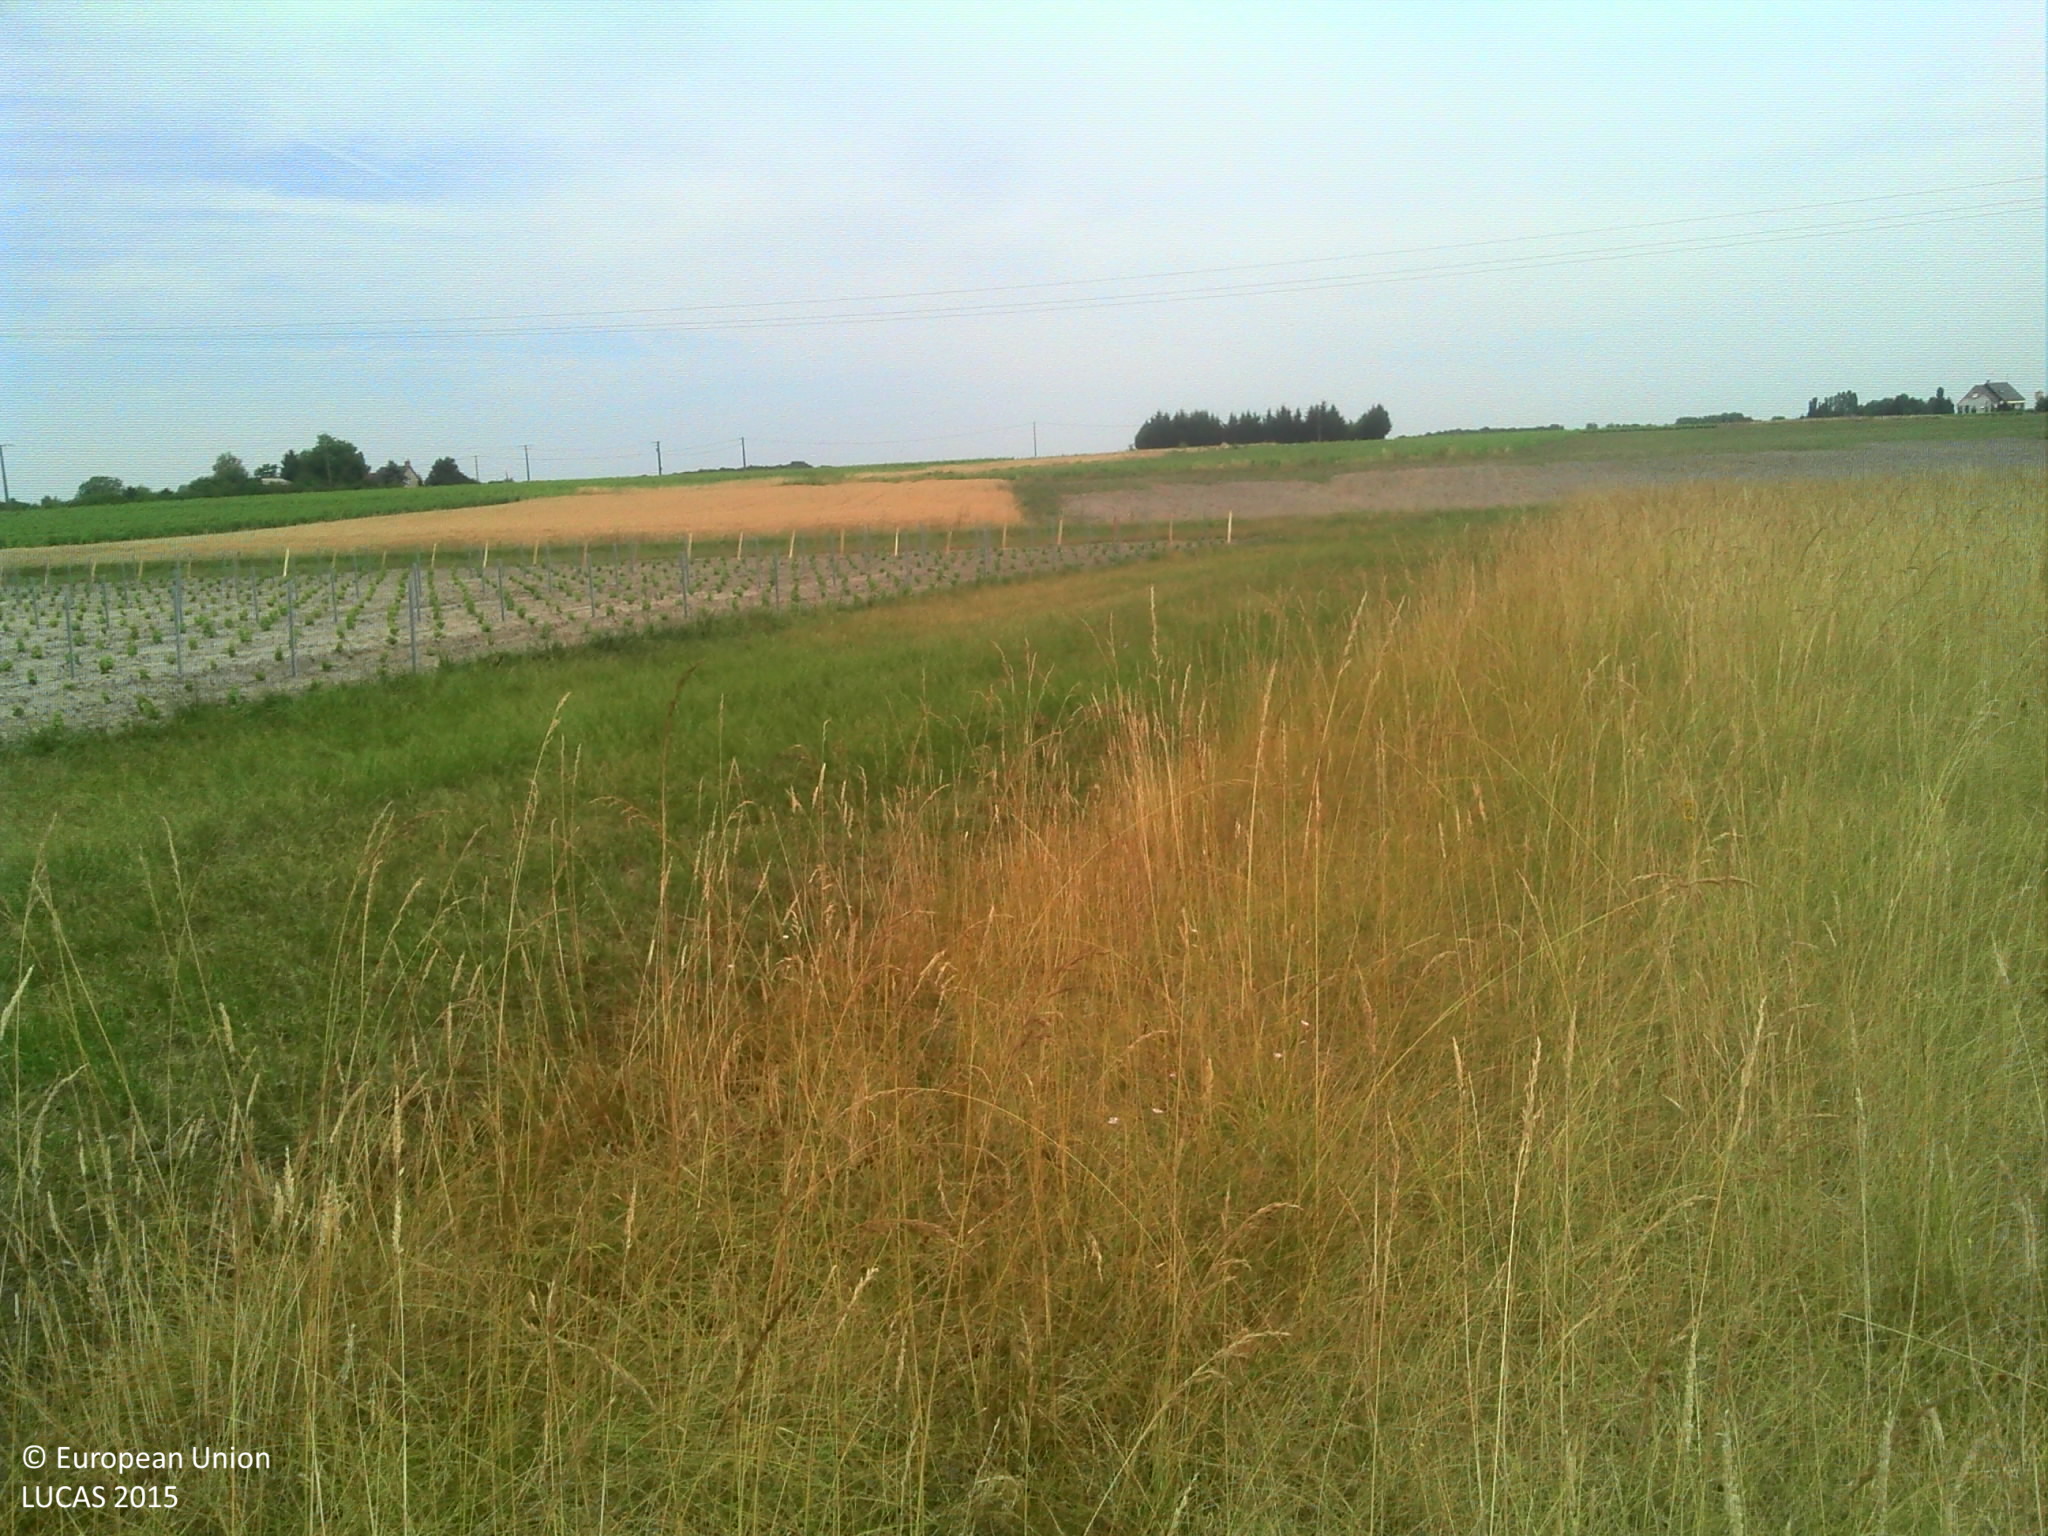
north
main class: Grassland
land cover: Grassland without tree/shrub cover
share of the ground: > 75 %
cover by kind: herbaceous plants 100 %
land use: Agriculture (excluding fallow land and kitchen gardens)
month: June
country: FR
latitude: 47.3616
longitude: 1.3928
